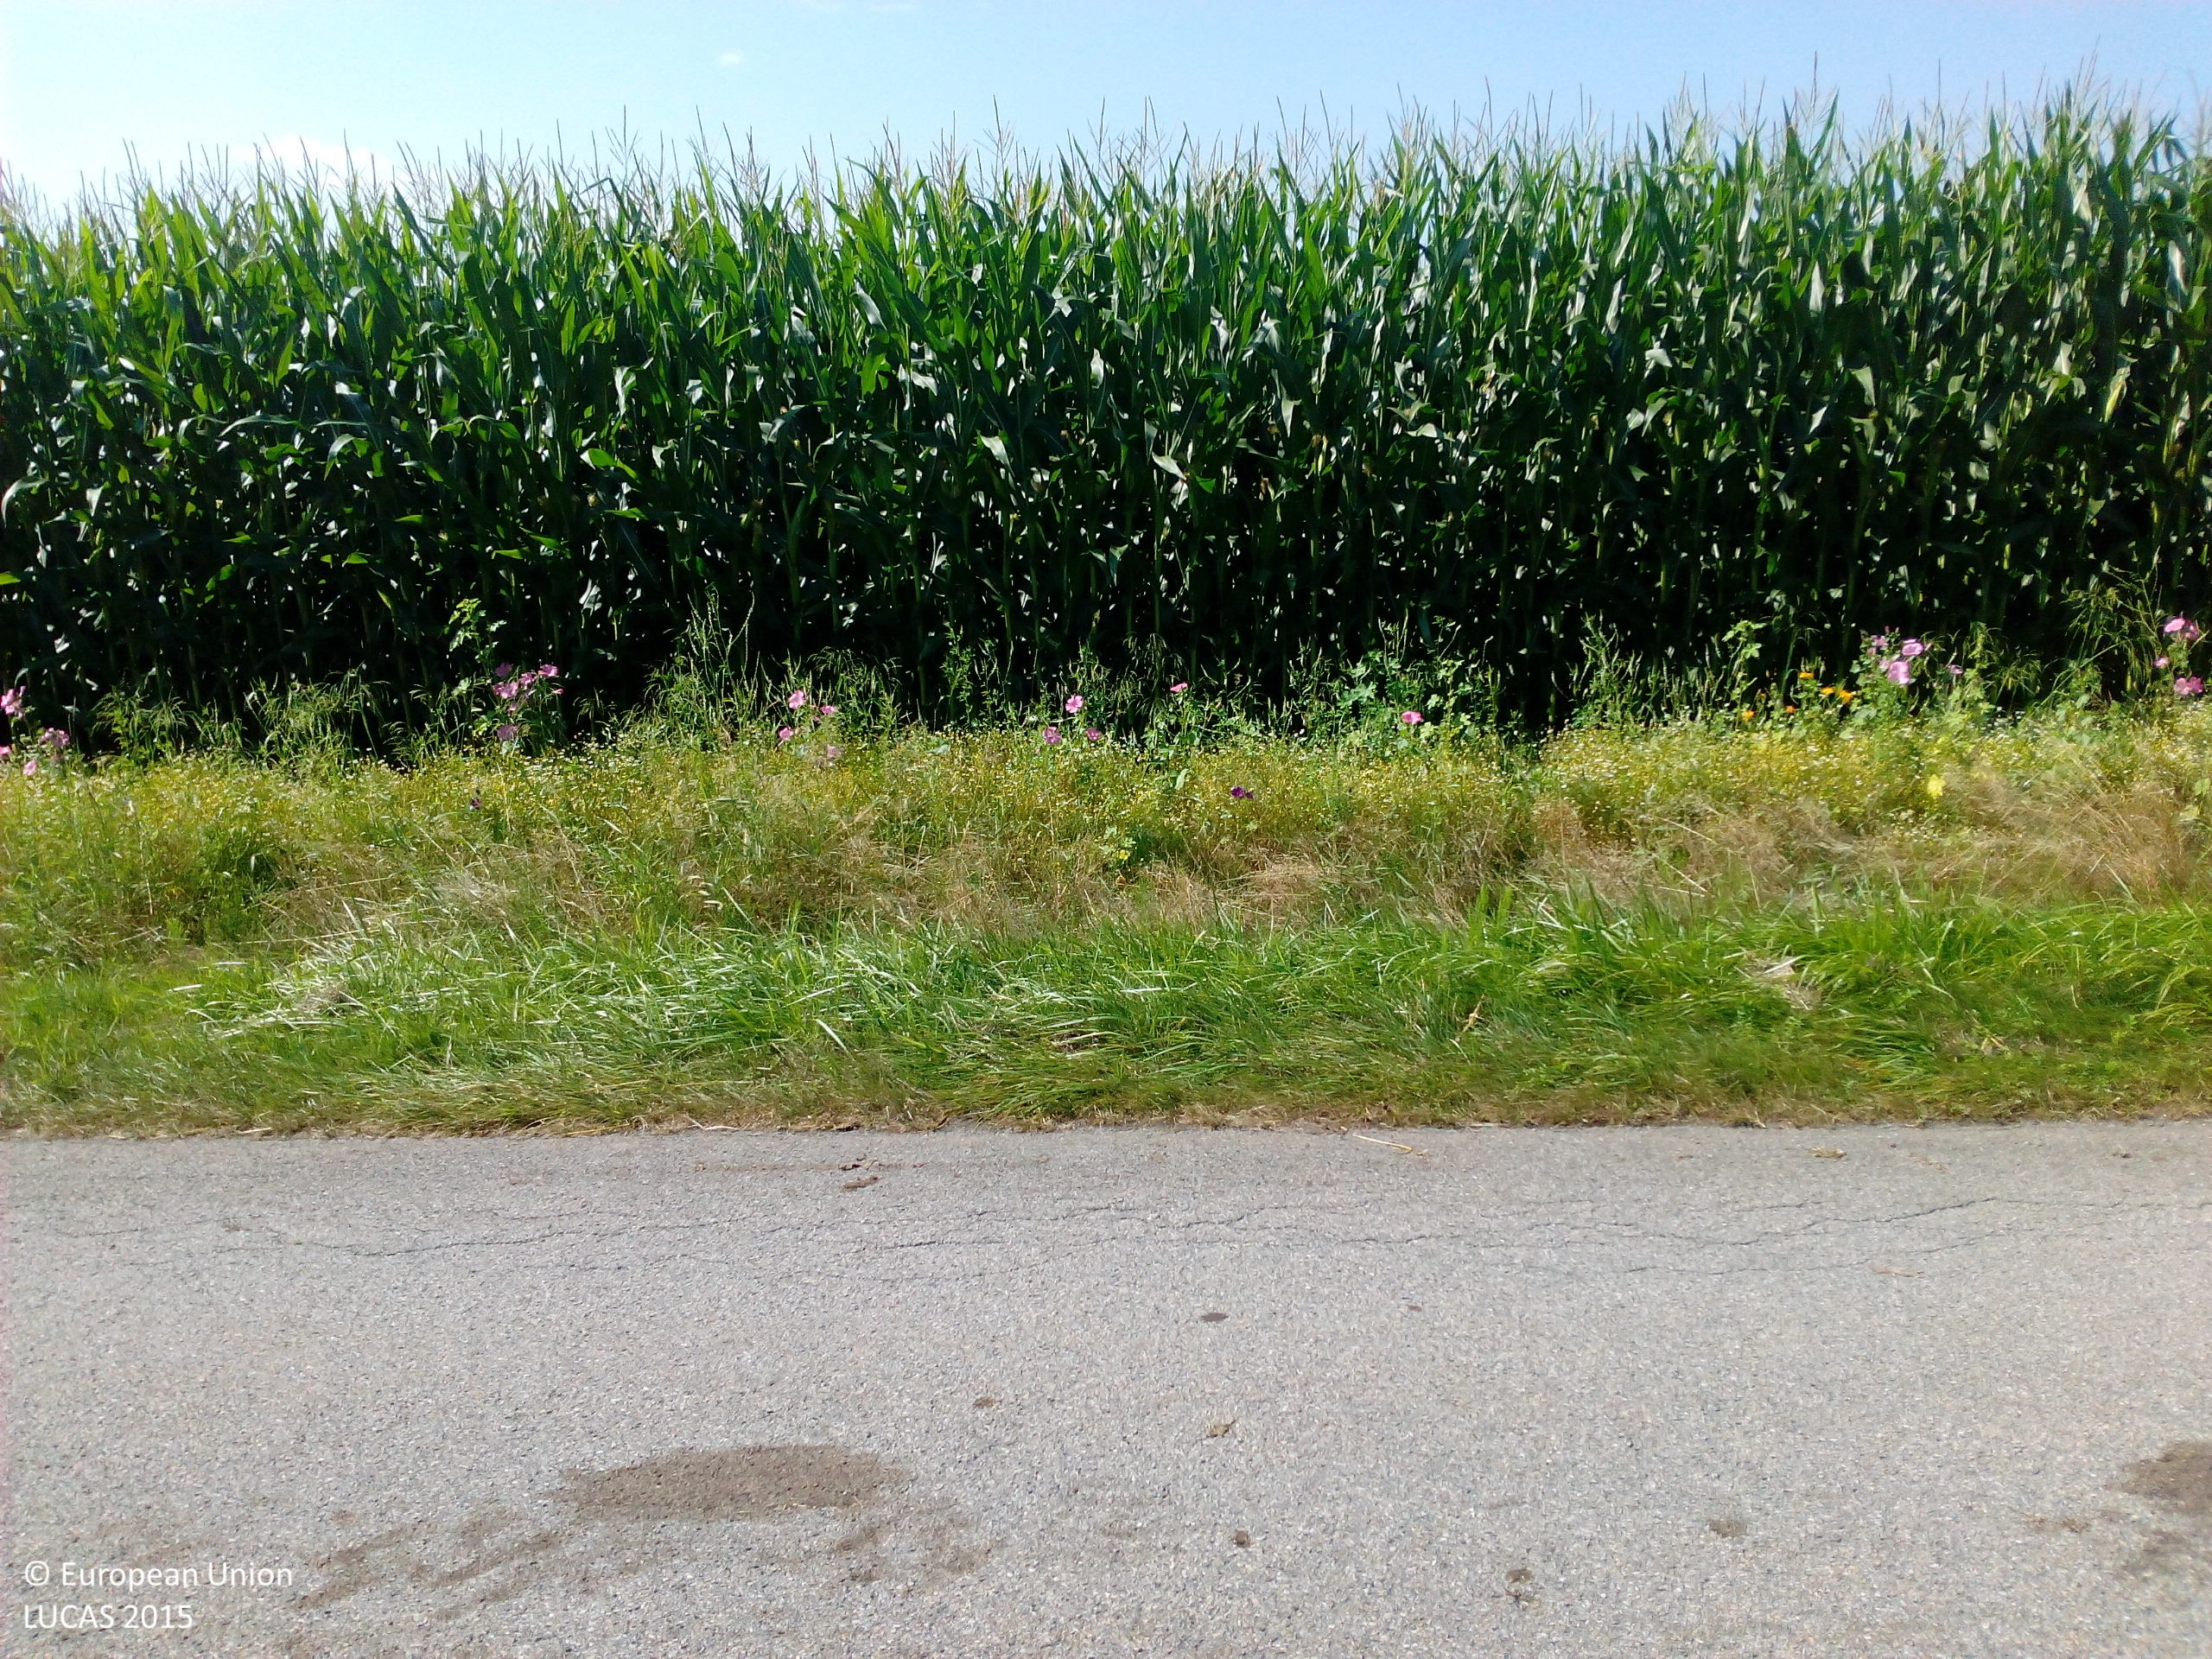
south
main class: Cropland
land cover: Maize
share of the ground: > 75 %
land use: Agriculture (excluding fallow land and kitchen gardens)
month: July
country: DE
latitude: 48.4823
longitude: 13.2328
